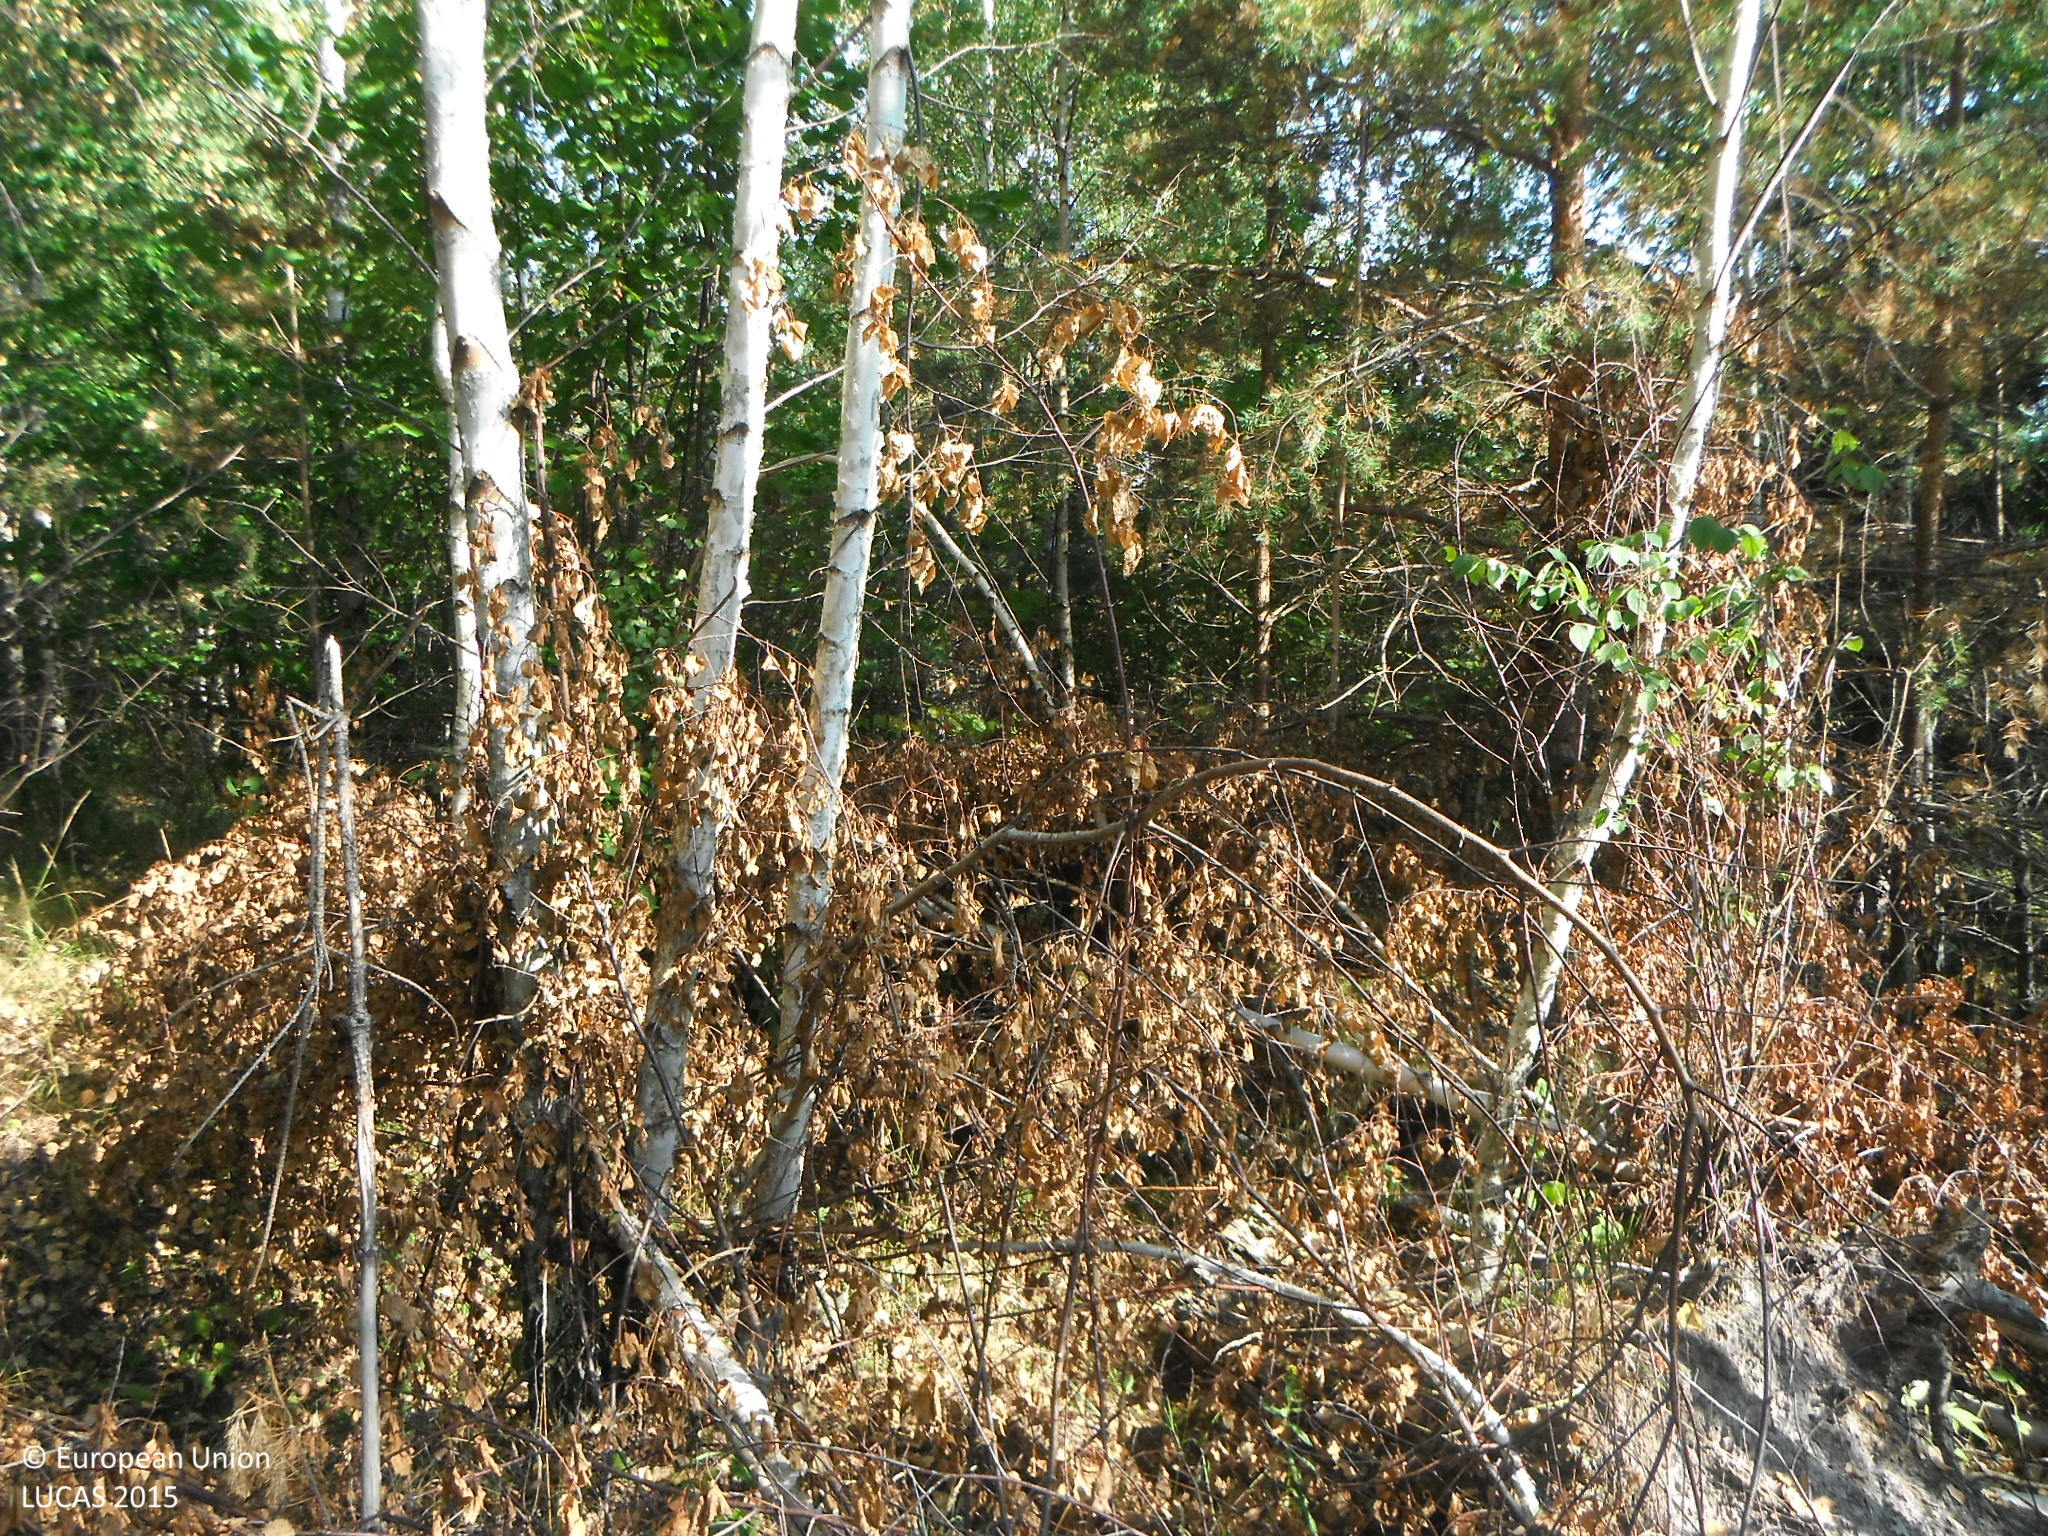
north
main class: Woodland
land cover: Spruce dominated mixed woodland
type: hemiboreal forest and nemoral coniferous forest and mixed broadleaved-coniferous forest
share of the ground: > 75 %
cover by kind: coniferous forest trees 60 %, broadleaved forest trees 40 %
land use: Forestry
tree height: > 5 m
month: September
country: SK
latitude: 48.9686
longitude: 20.3478
